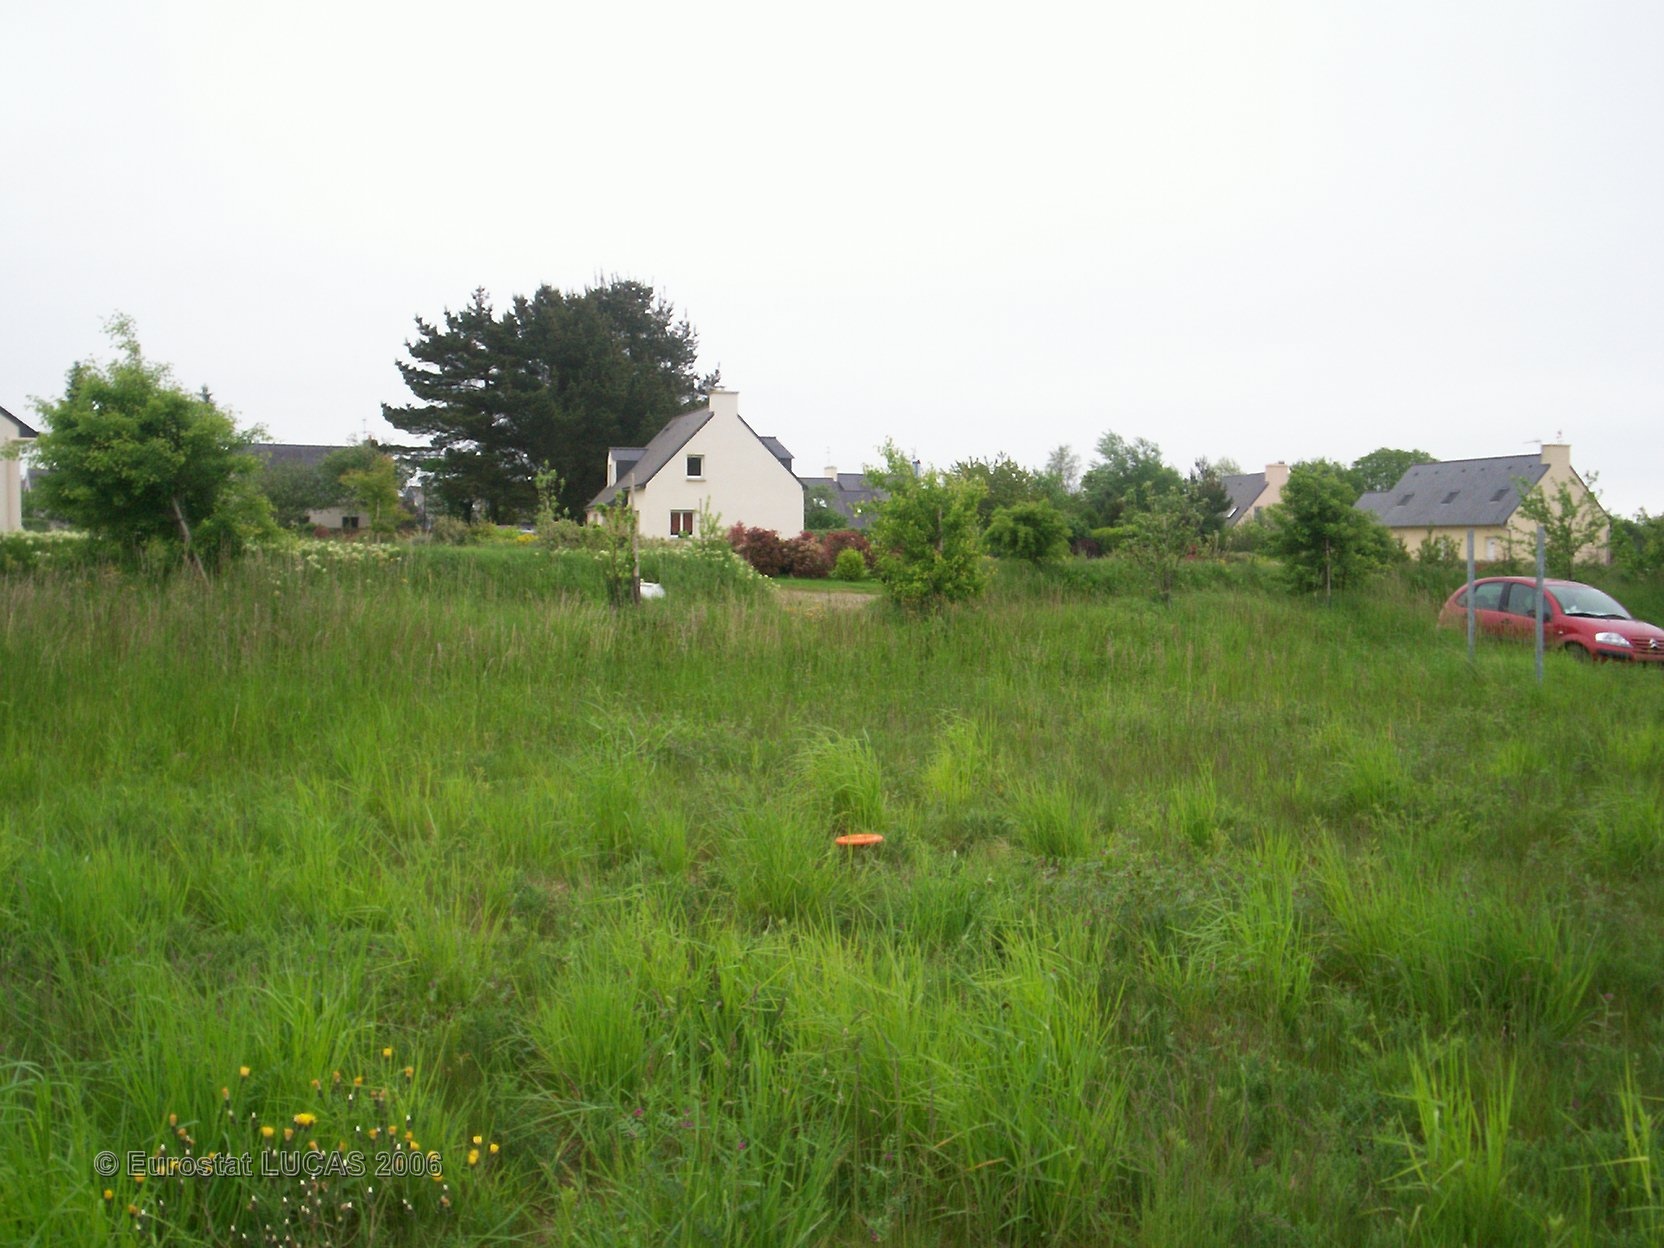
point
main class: Grassland
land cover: Grassland without tree/shrub cover
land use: Fallow land
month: May
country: FR
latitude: 47.7810
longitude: -3.5699
